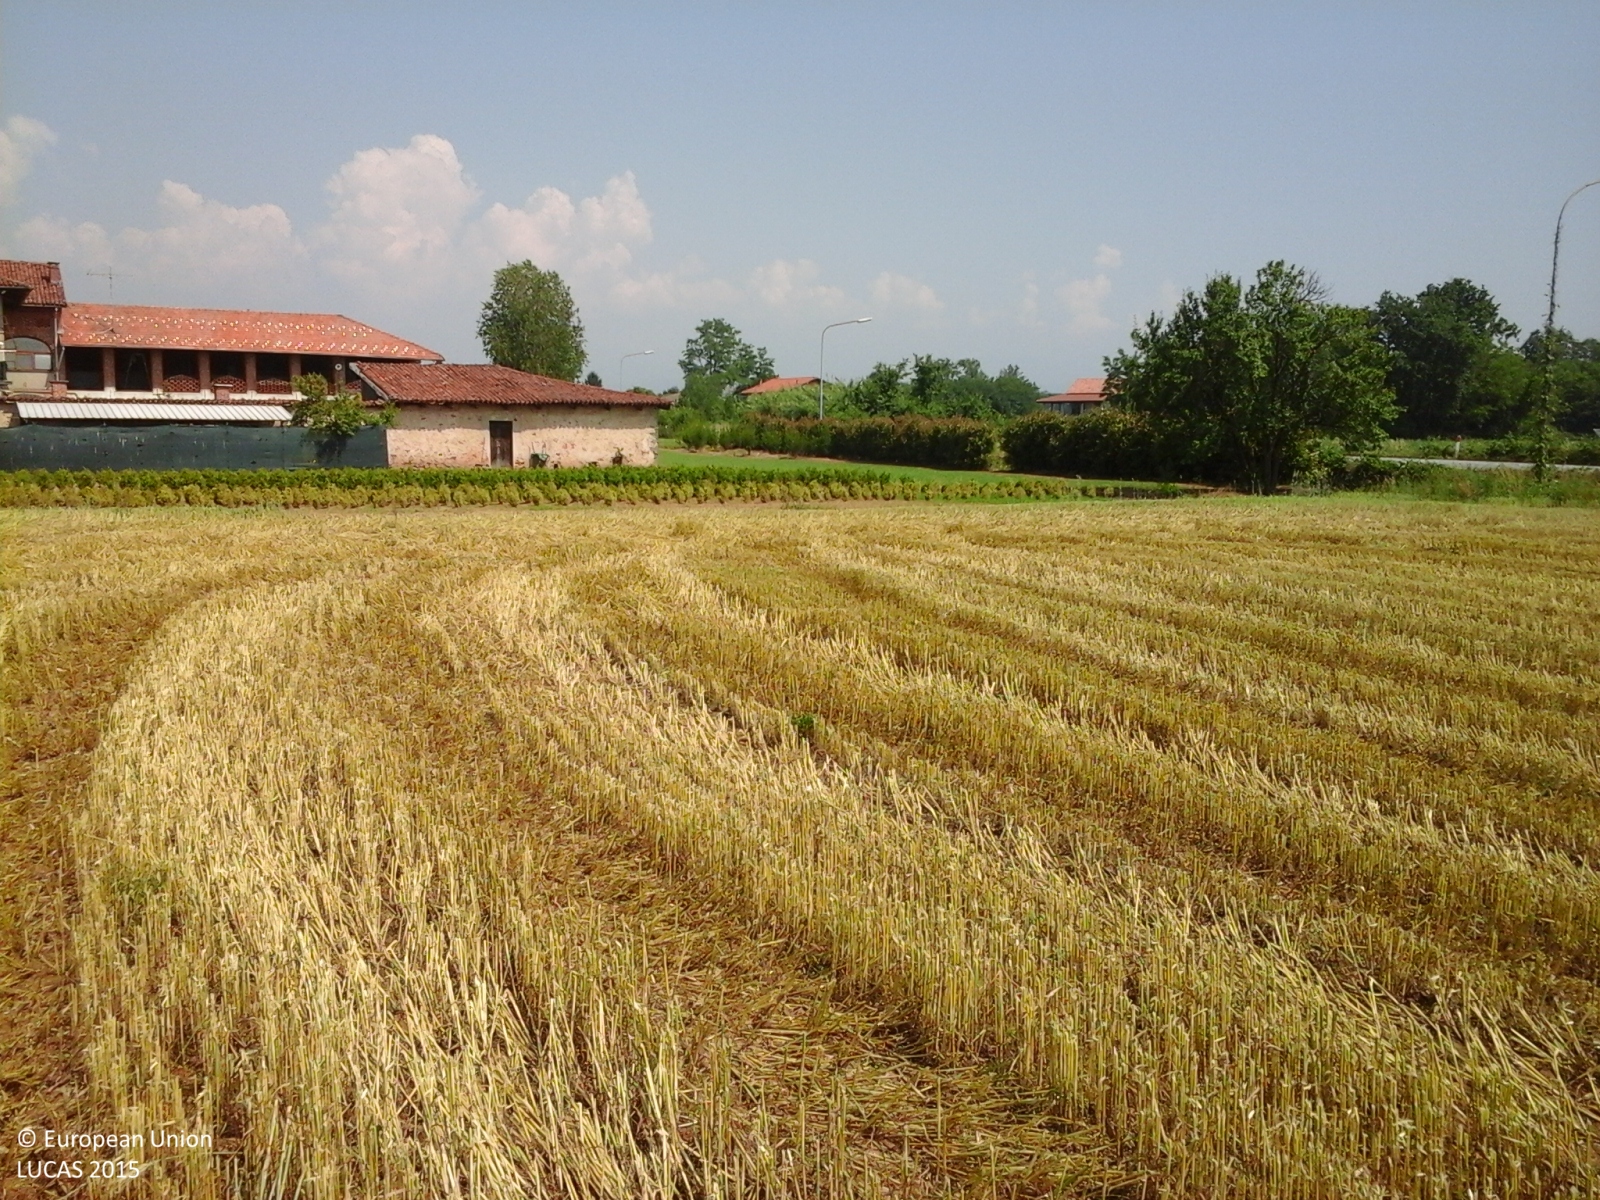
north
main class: Cropland
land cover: Mixed cereals for fodder
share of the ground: > 75 %
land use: Agriculture (excluding fallow land and kitchen gardens)
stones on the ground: 10 - 25 %
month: June
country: IT
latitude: 45.4692
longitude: 8.0973
